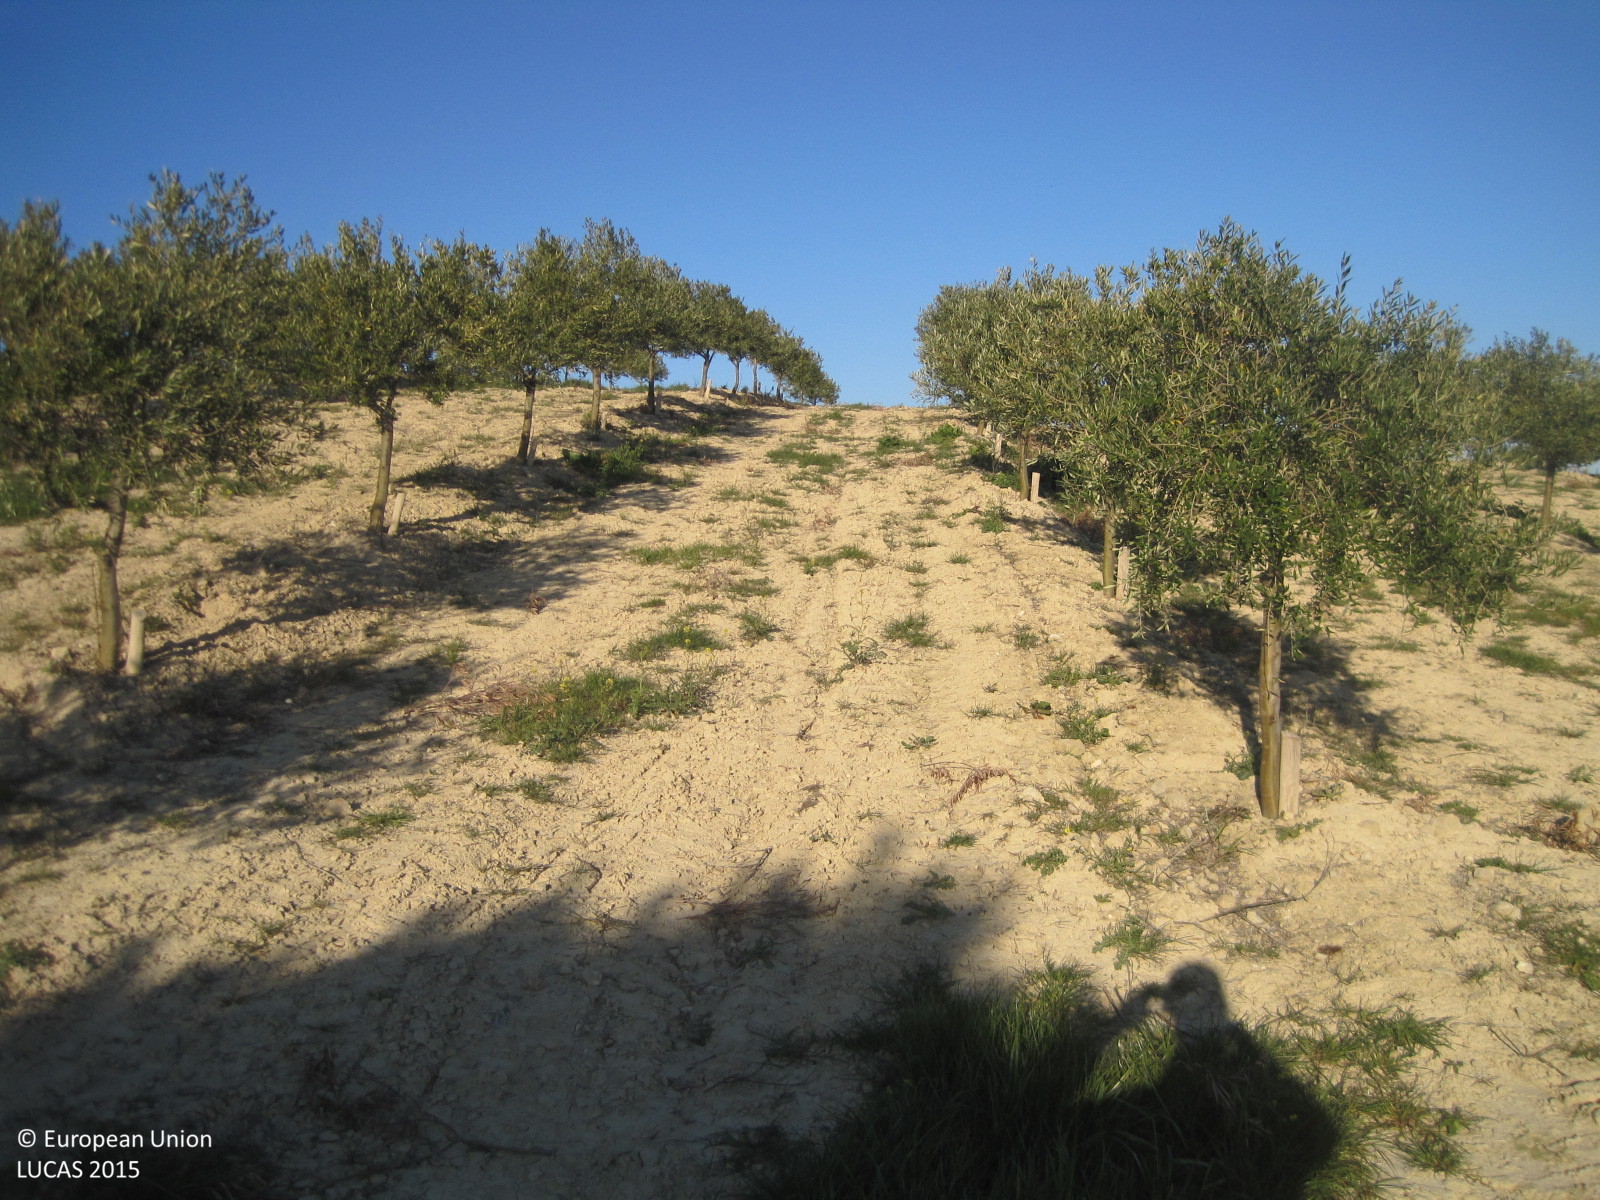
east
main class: Cropland
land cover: Olive groves
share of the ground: 10 - 25 %
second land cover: Other bare soil
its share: > 75 %
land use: Agriculture (excluding fallow land and kitchen gardens)
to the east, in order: Olive groves; Other bare soil; Shrubland with sparse tree cover; Barley; Shrubland with sparse tree cover; Barley; Grass margins; Paved roads, cycling and walking lanes; Grass margins; Shrubland with sparse tree cover; Vineyards
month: April
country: ES
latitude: 42.5393
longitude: -2.4531
